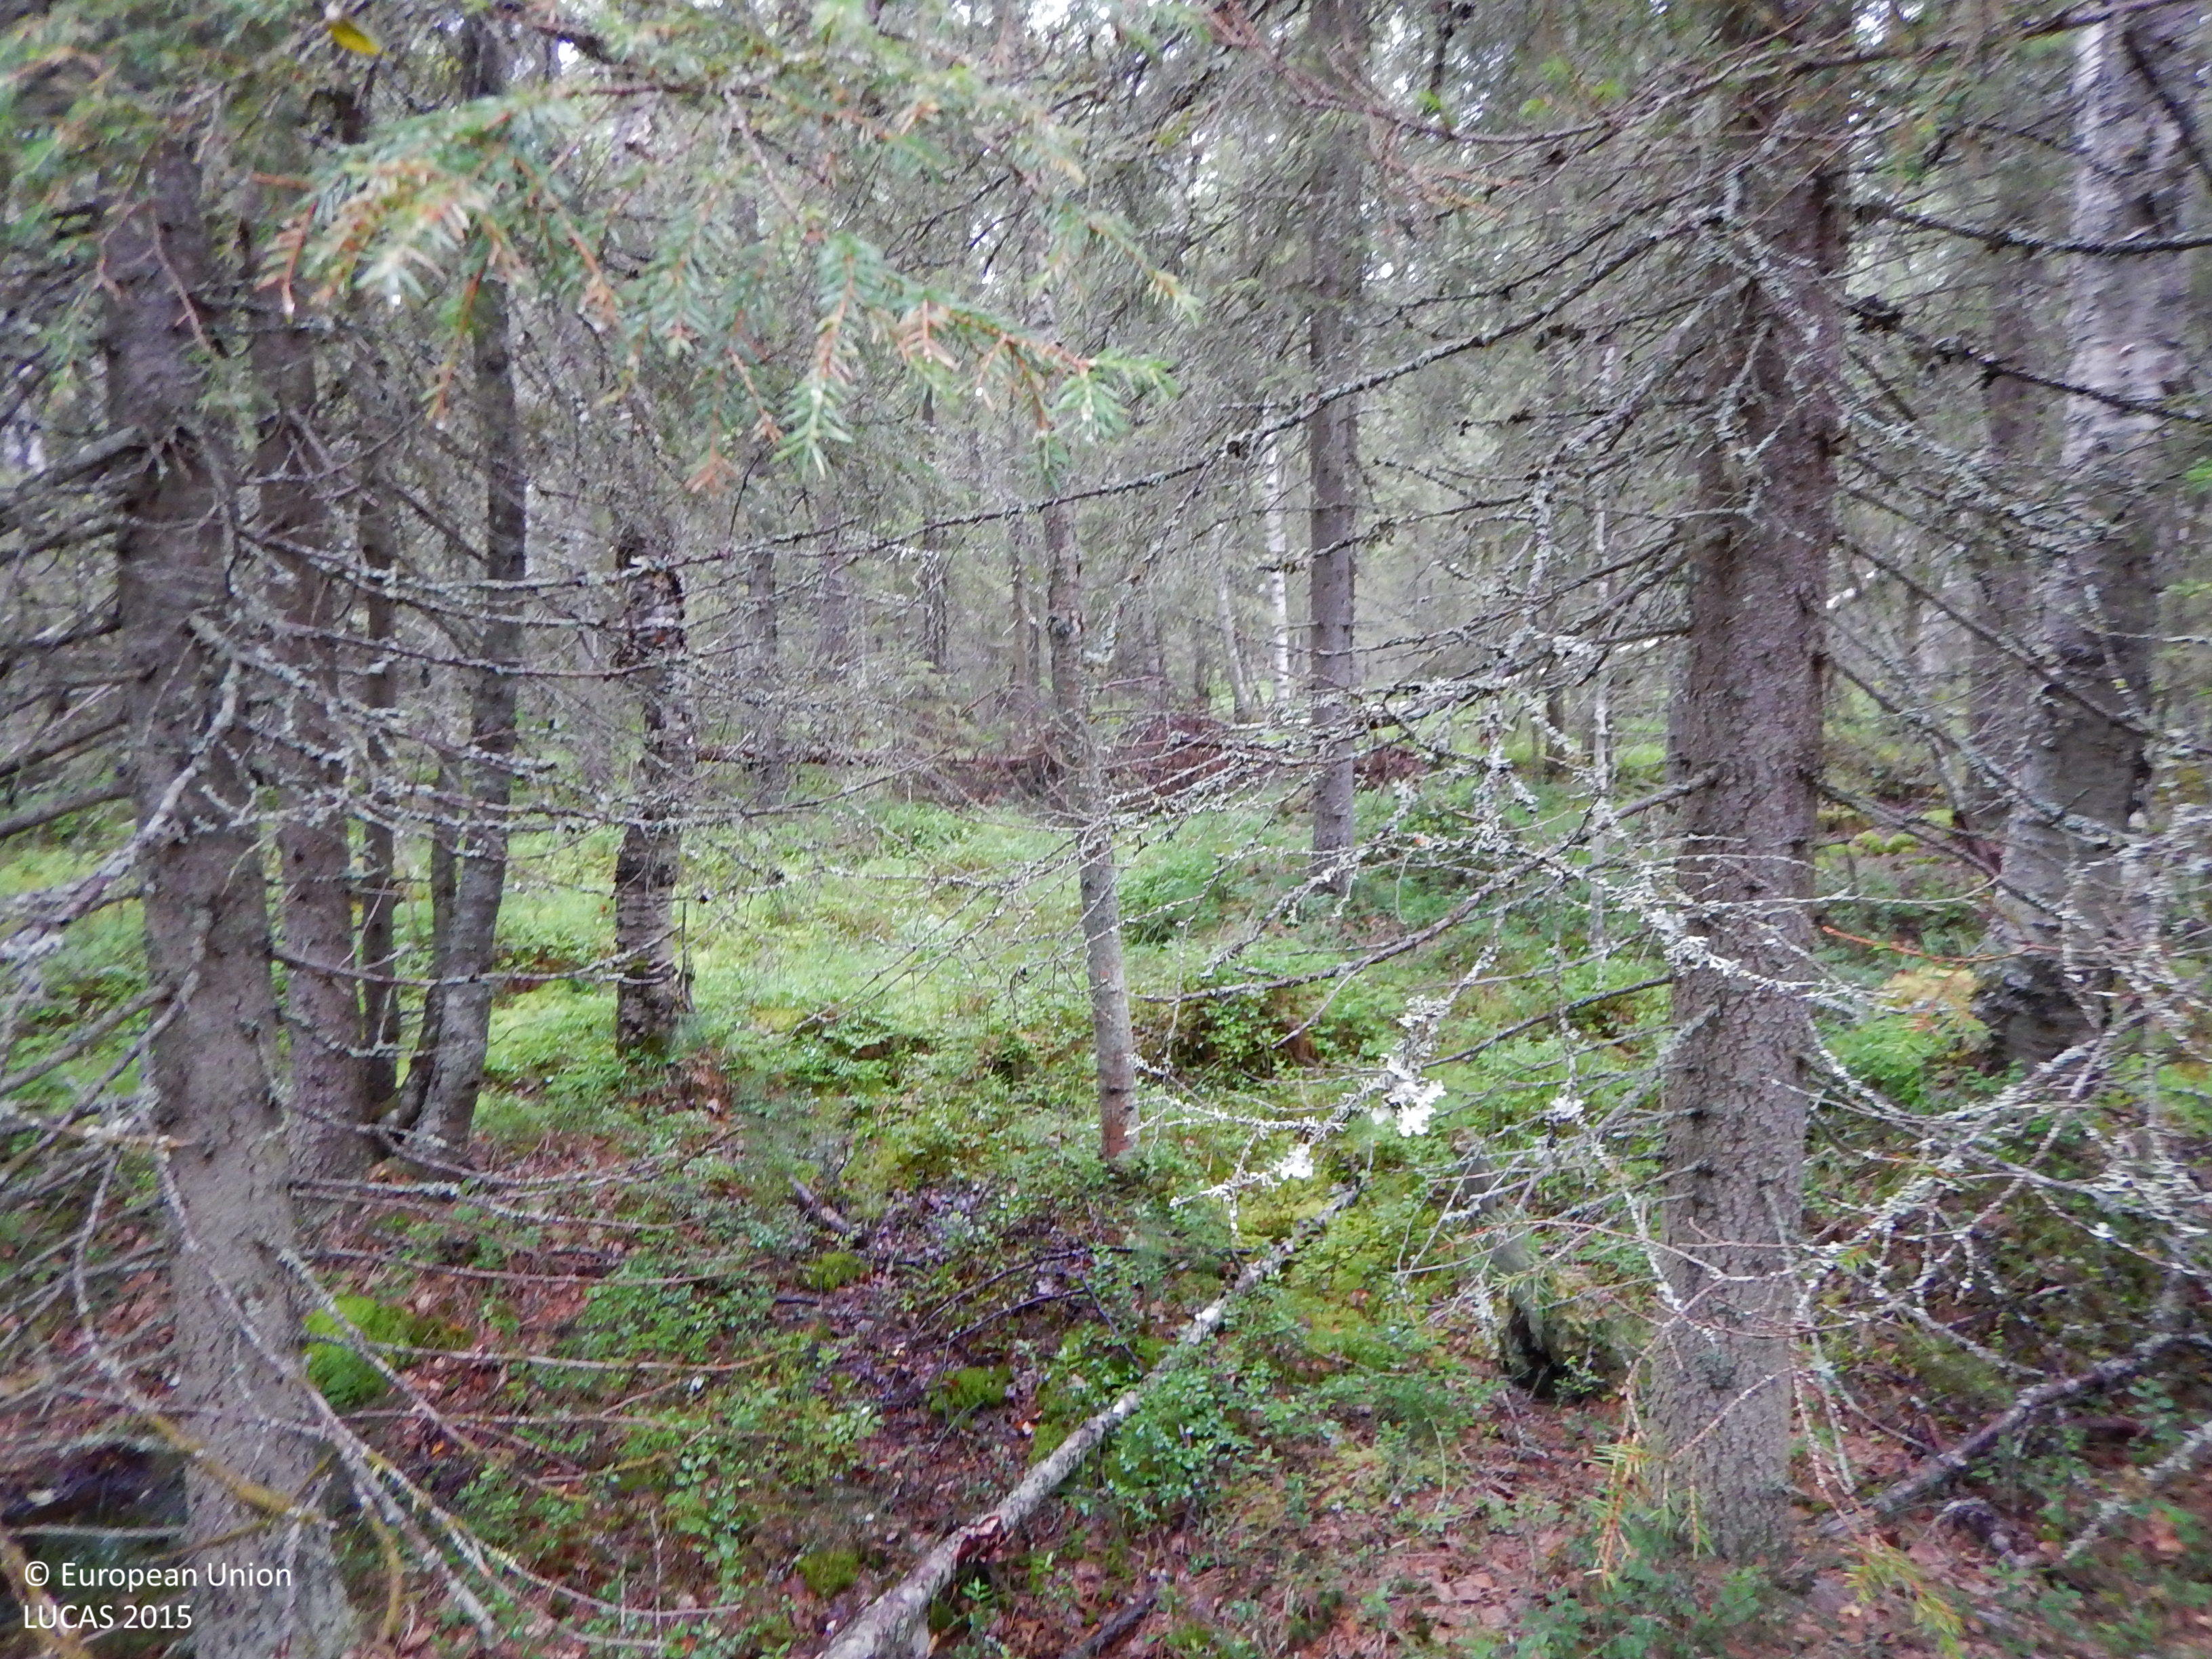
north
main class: Woodland
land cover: Spruce dominated mixed woodland
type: mire and swamp forests
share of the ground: 50 - 75 %
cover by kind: coniferous forest trees 45 %, broadleaved forest trees 15 %, shrubs 15 %, lichens and mosses 15 %, herbaceous plants 10 %
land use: Forestry
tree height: > 5 m
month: July
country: SE
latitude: 65.0182
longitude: 20.4763
